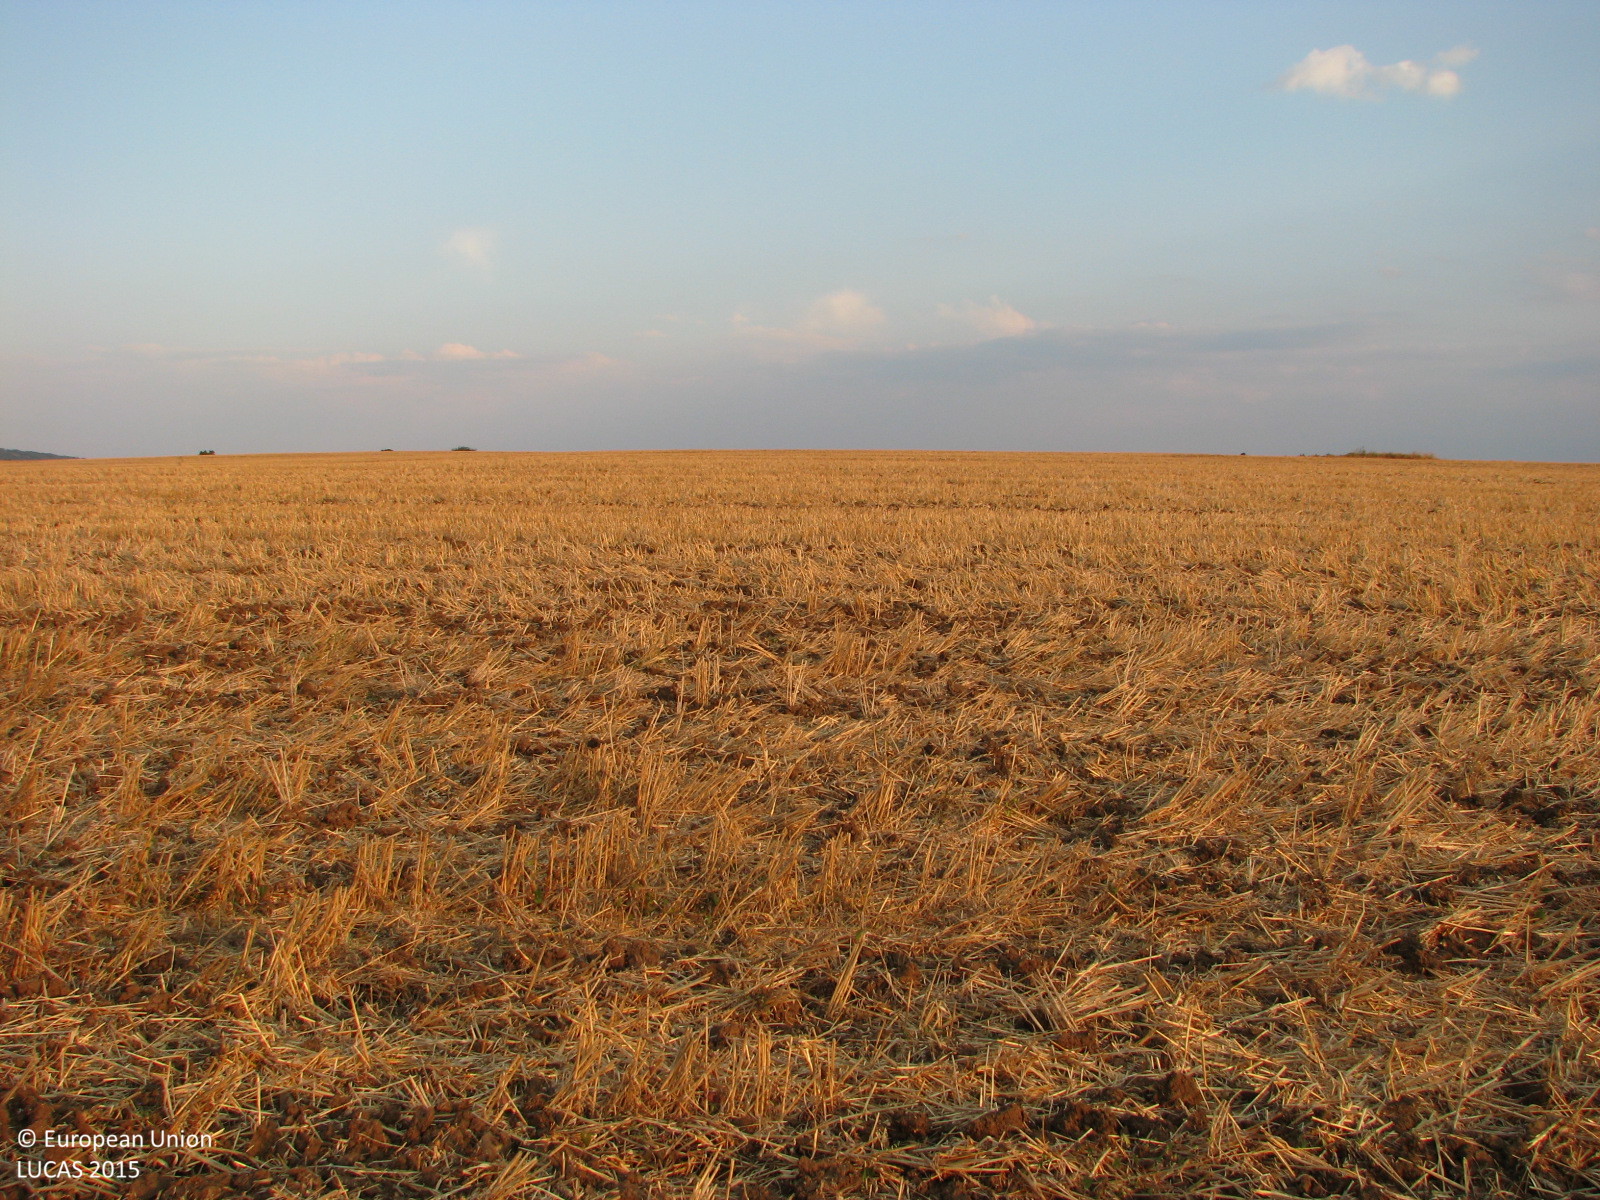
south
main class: Cropland
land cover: Common wheat
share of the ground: 25 - 50 %
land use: Agriculture (excluding fallow land and kitchen gardens)
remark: Harvested field
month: August
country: BG
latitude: 42.1808
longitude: 26.8901
